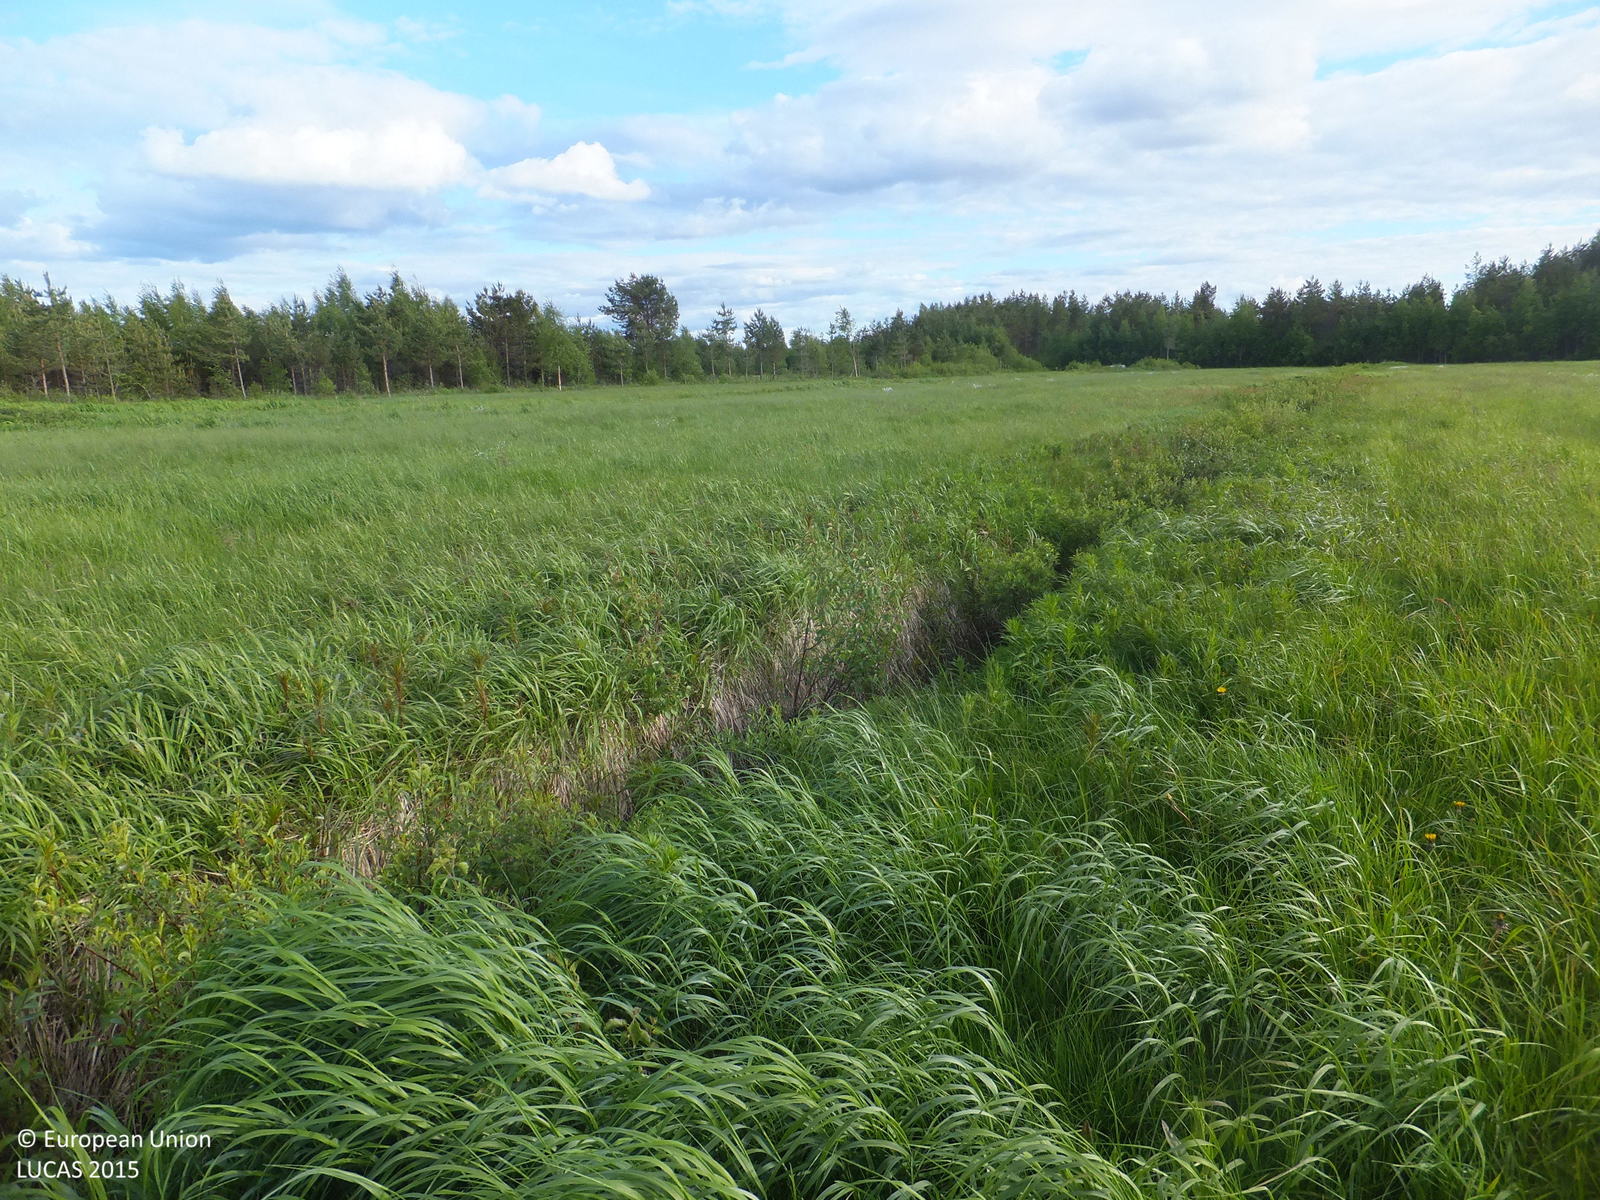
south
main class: Cropland
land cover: Temporary grasslands
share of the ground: > 75 %
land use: Agriculture (excluding fallow land and kitchen gardens)
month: June
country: FI
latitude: 63.6777
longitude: 24.2428
